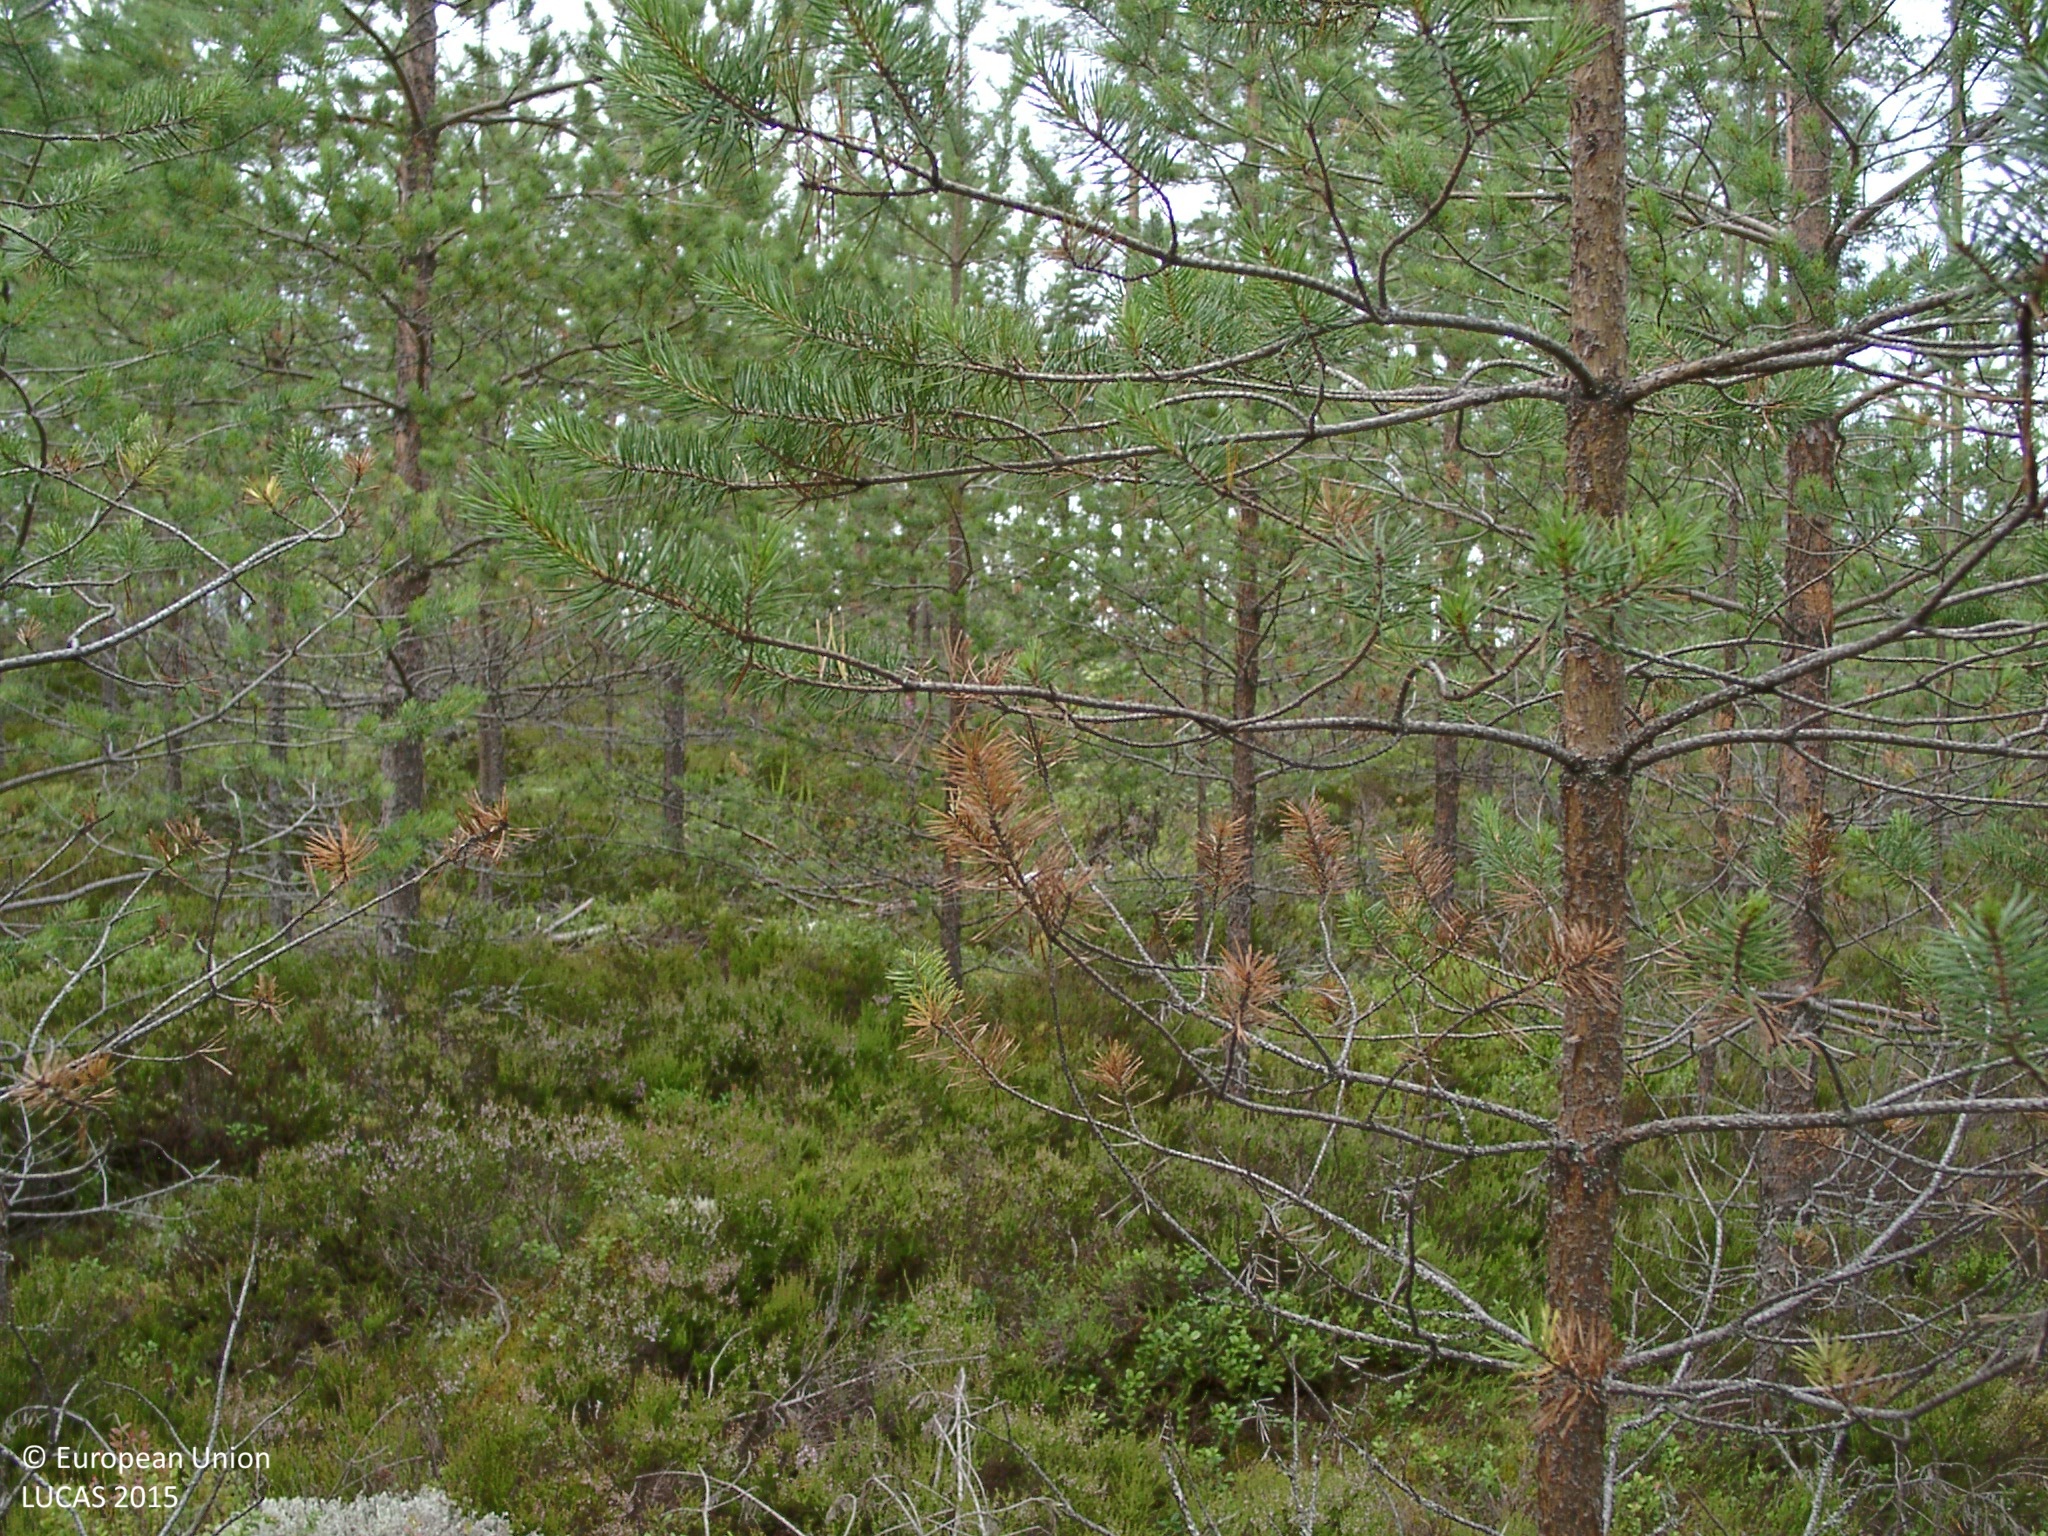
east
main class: Woodland
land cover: Pine dominated coniferous woodland
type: boreal forest
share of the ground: 50 - 75 %
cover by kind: coniferous forest trees 50 %, shrubs 35 %, lichens and mosses 15 %
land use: Forestry
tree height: < 5 m
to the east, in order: Pine dominated coniferous woodland; Tracks; Shrubland without tree cover; Pine dominated coniferous woodland; Shrubland without tree cover; Other mixed woodland; Inland fresh water bodies
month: July
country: FI
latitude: 62.7249
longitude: 24.5832
